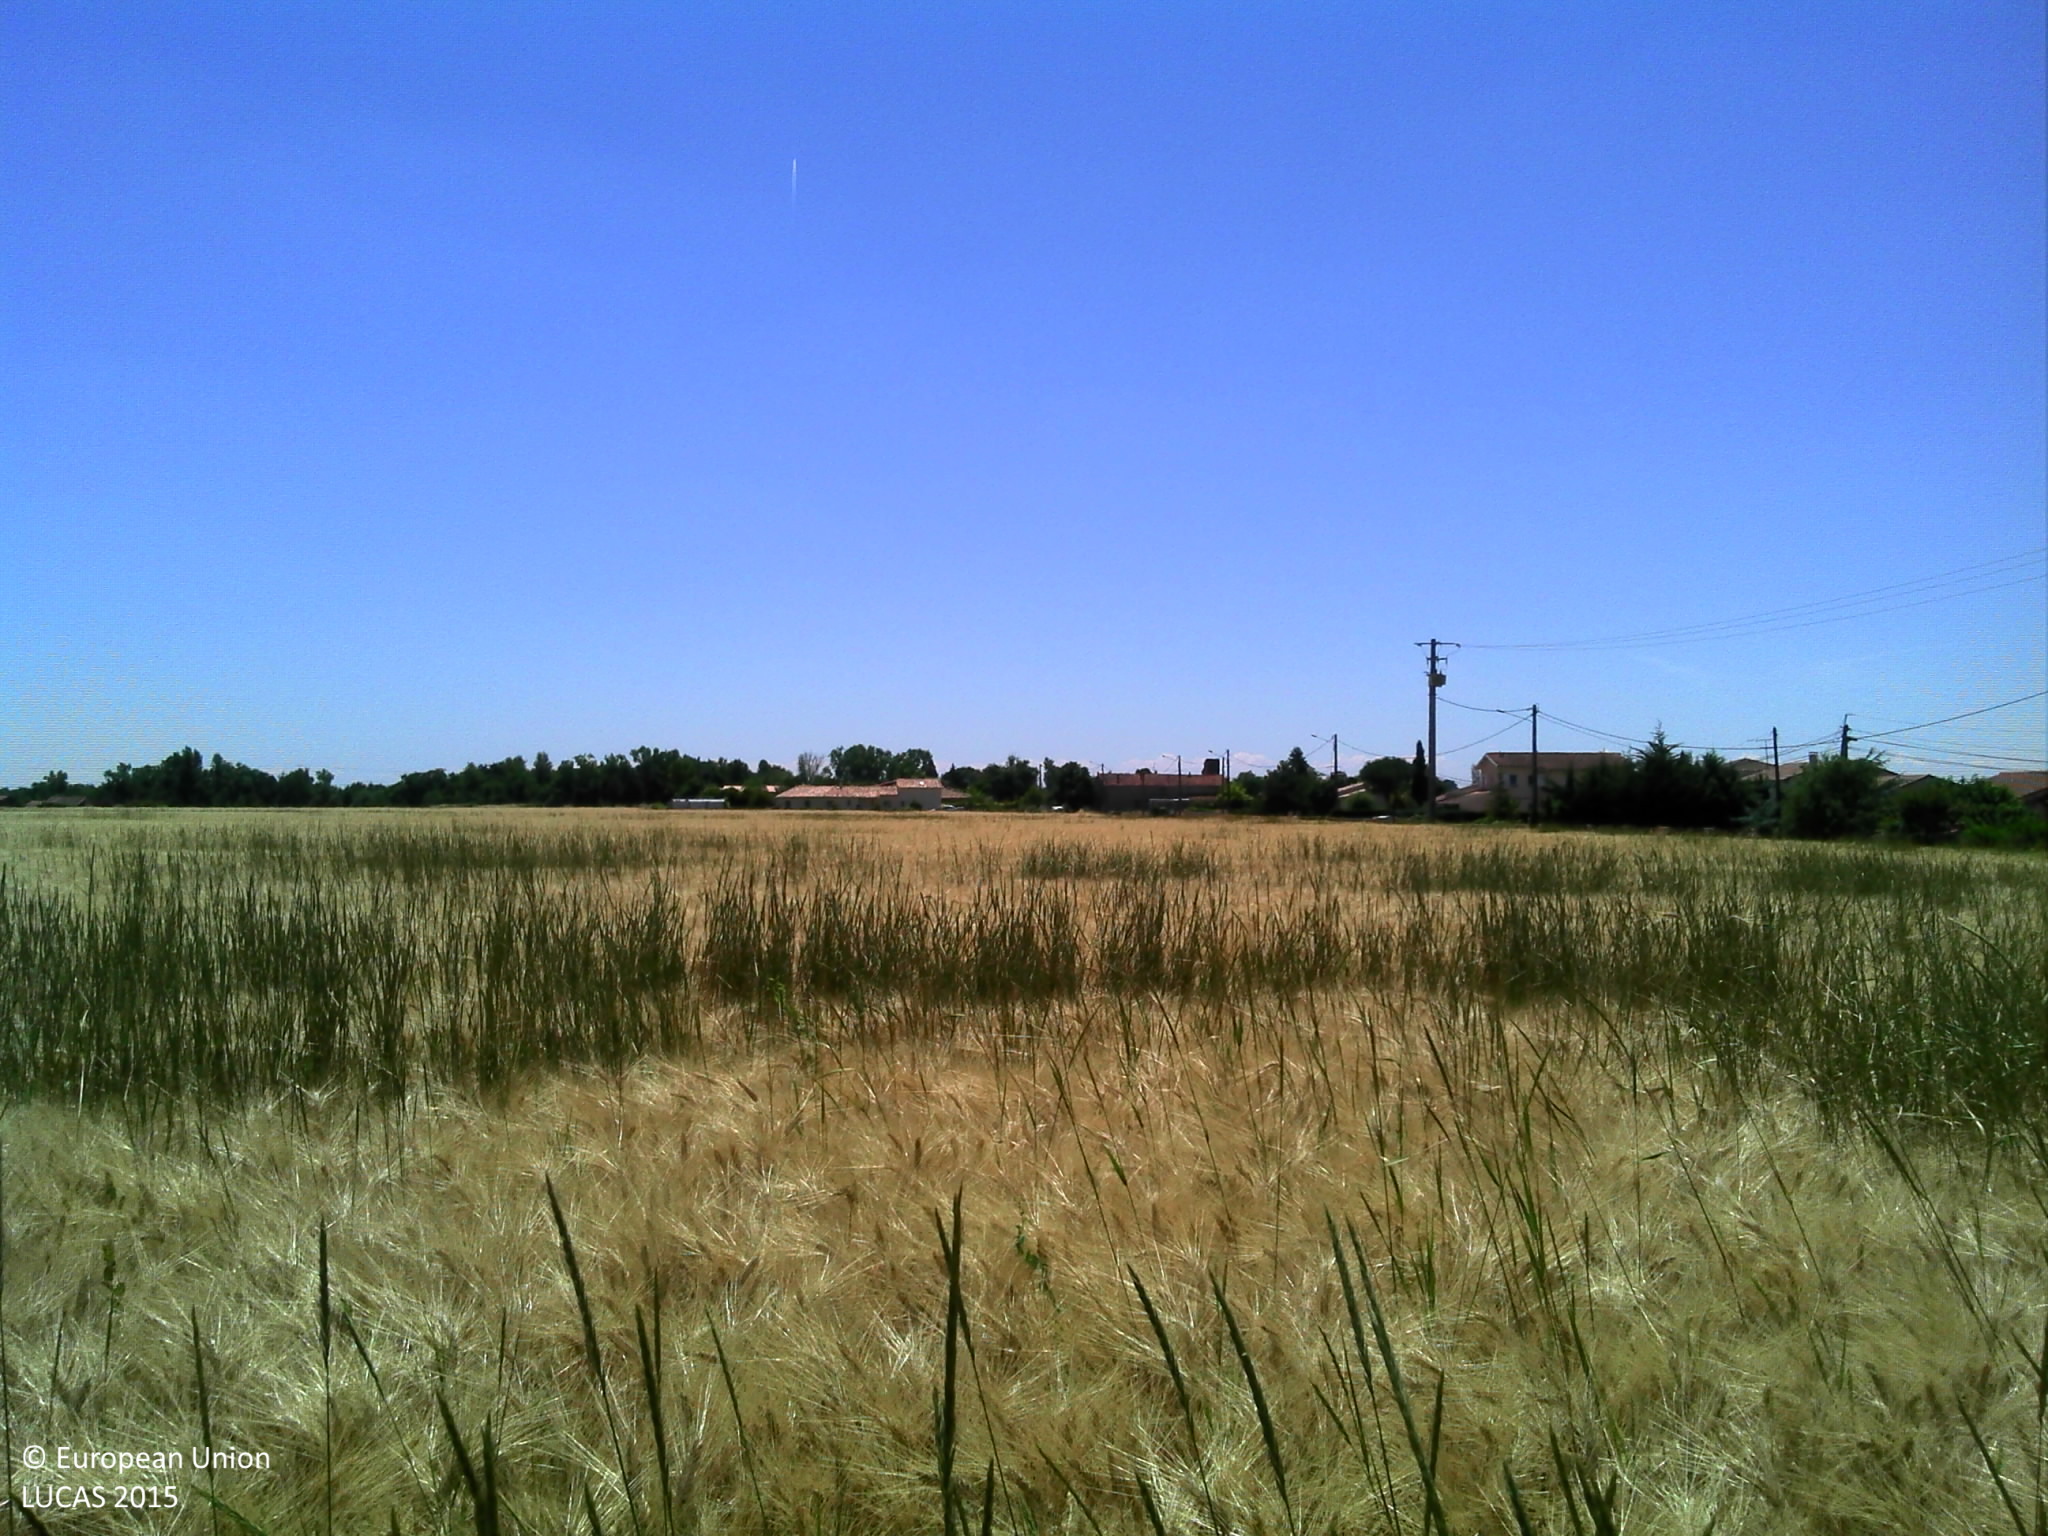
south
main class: Cropland
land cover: Barley
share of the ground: > 75 %
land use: Agriculture (excluding fallow land and kitchen gardens)
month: June
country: FR
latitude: 43.7127
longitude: 1.3011
